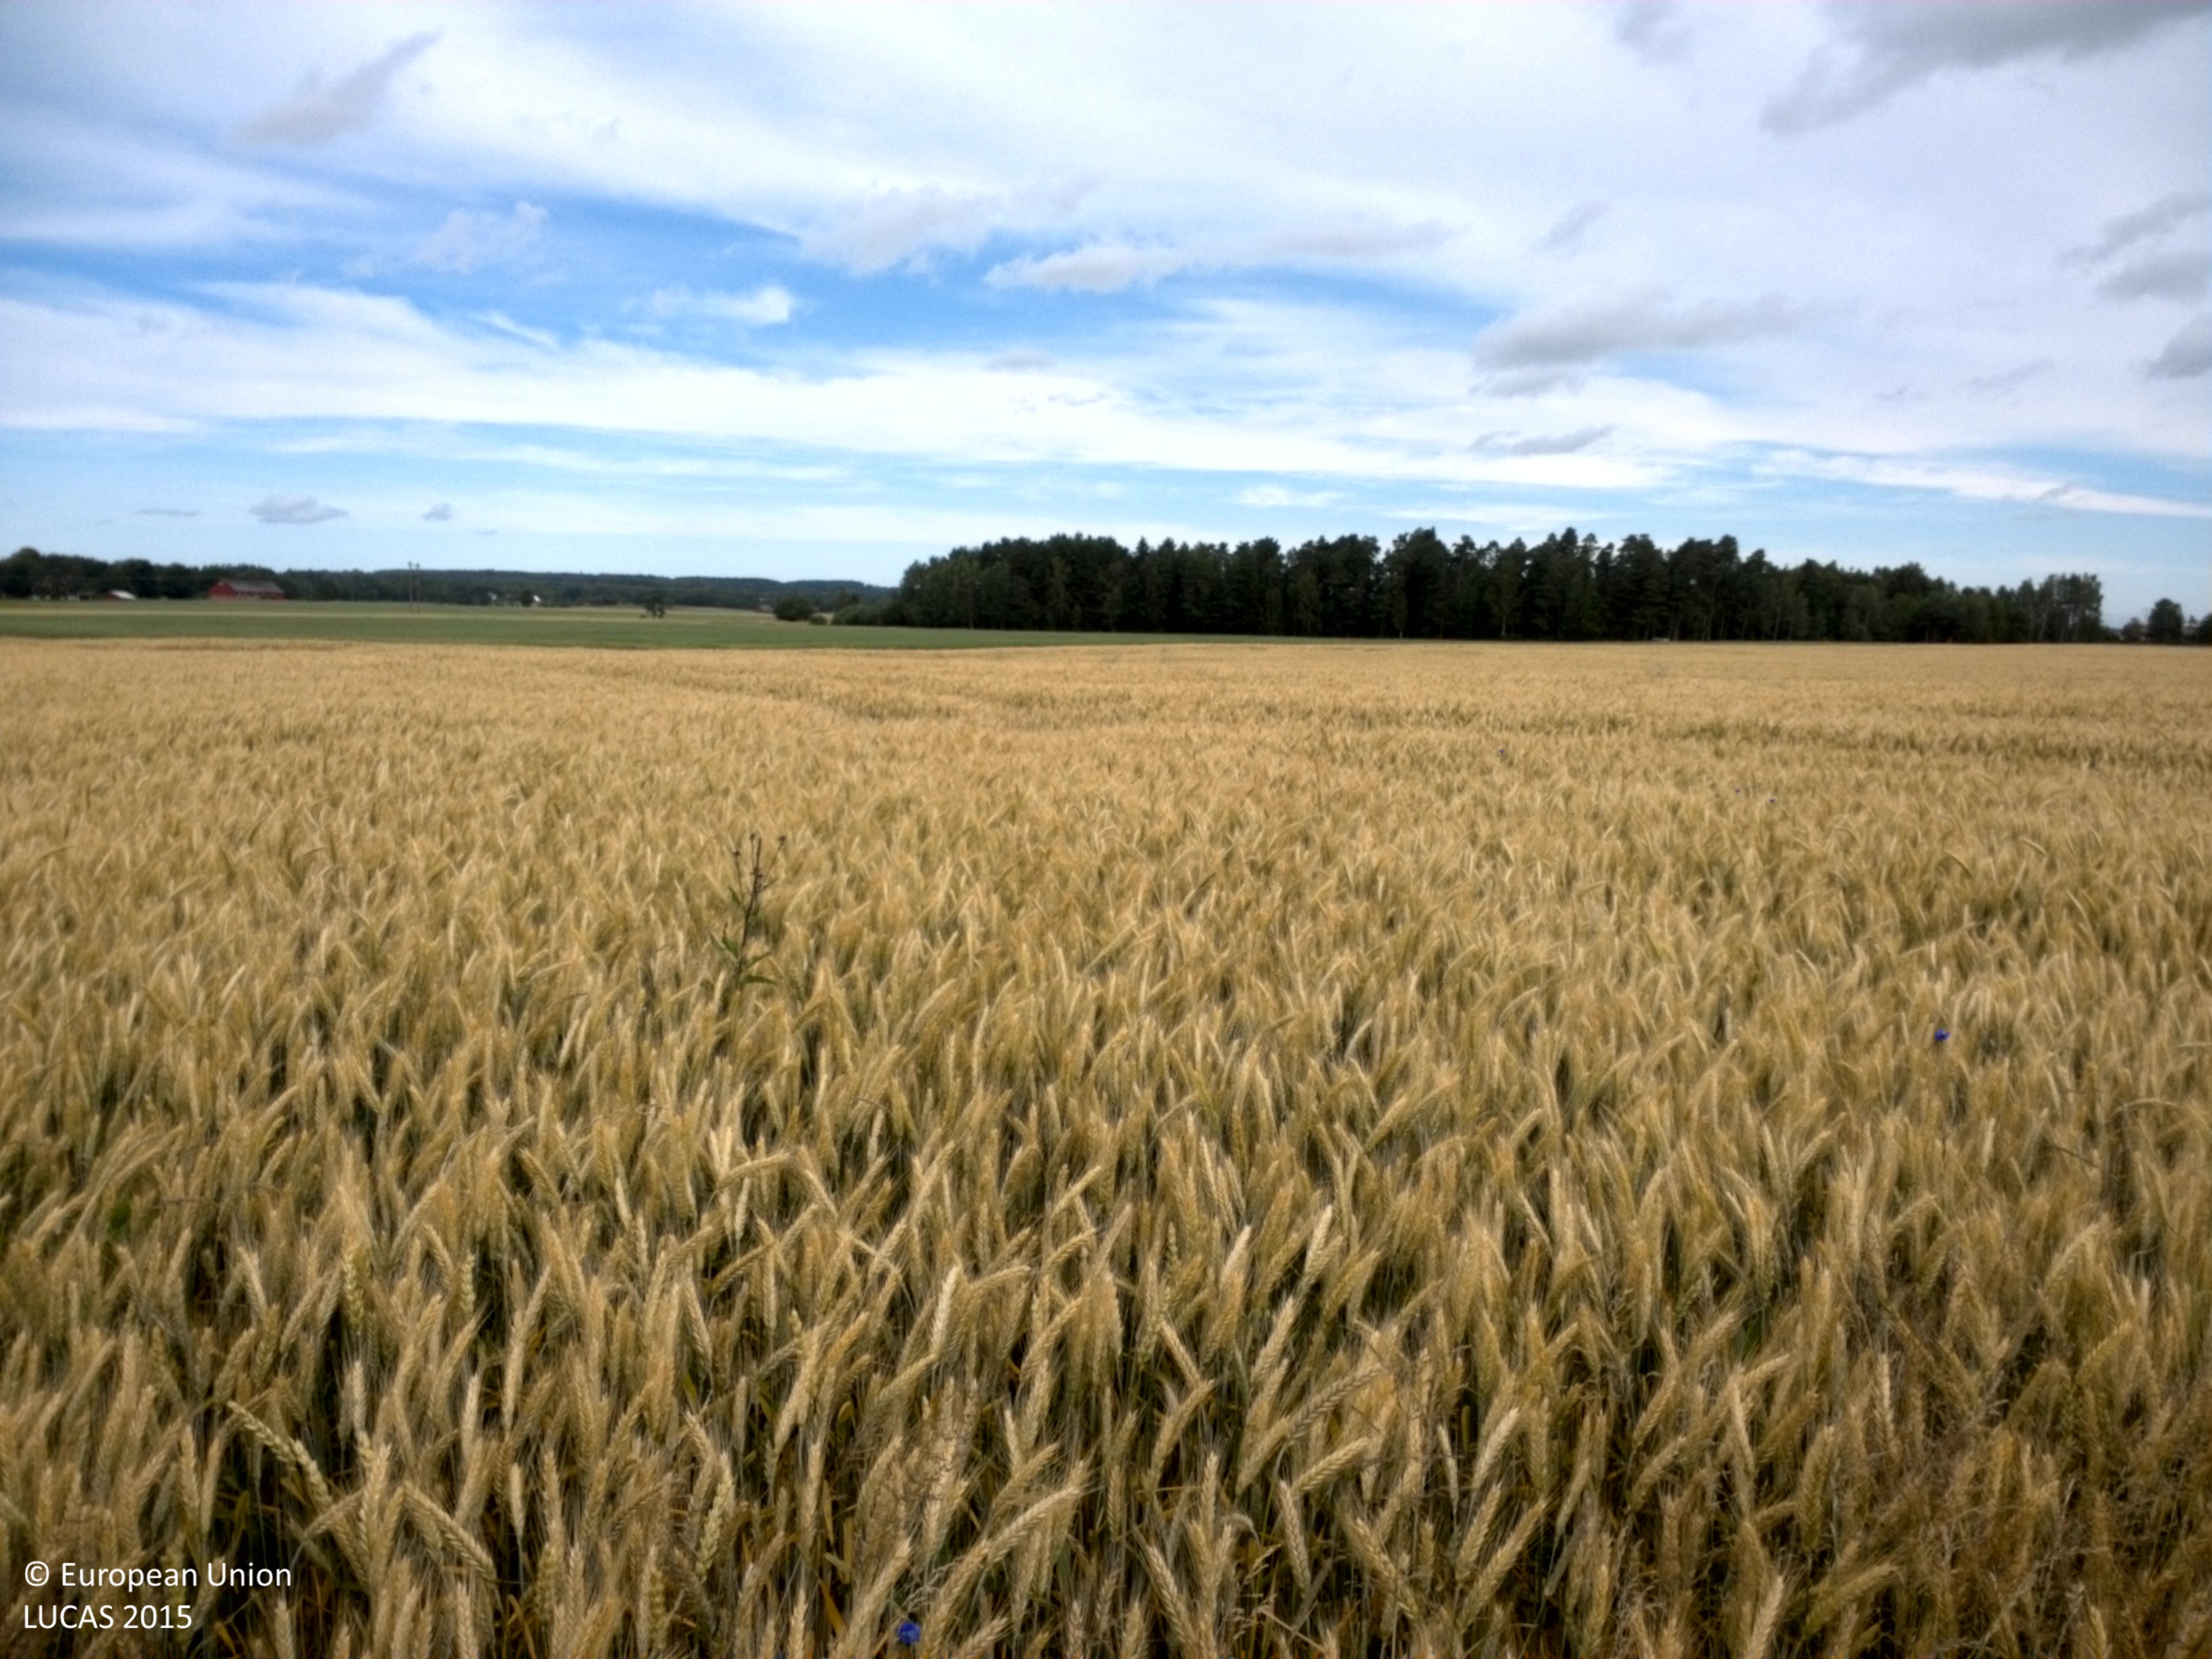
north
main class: Cropland
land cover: Oats
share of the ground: > 75 %
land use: Agriculture (excluding fallow land and kitchen gardens)
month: July
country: SE
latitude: 58.5013
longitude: 13.3744
